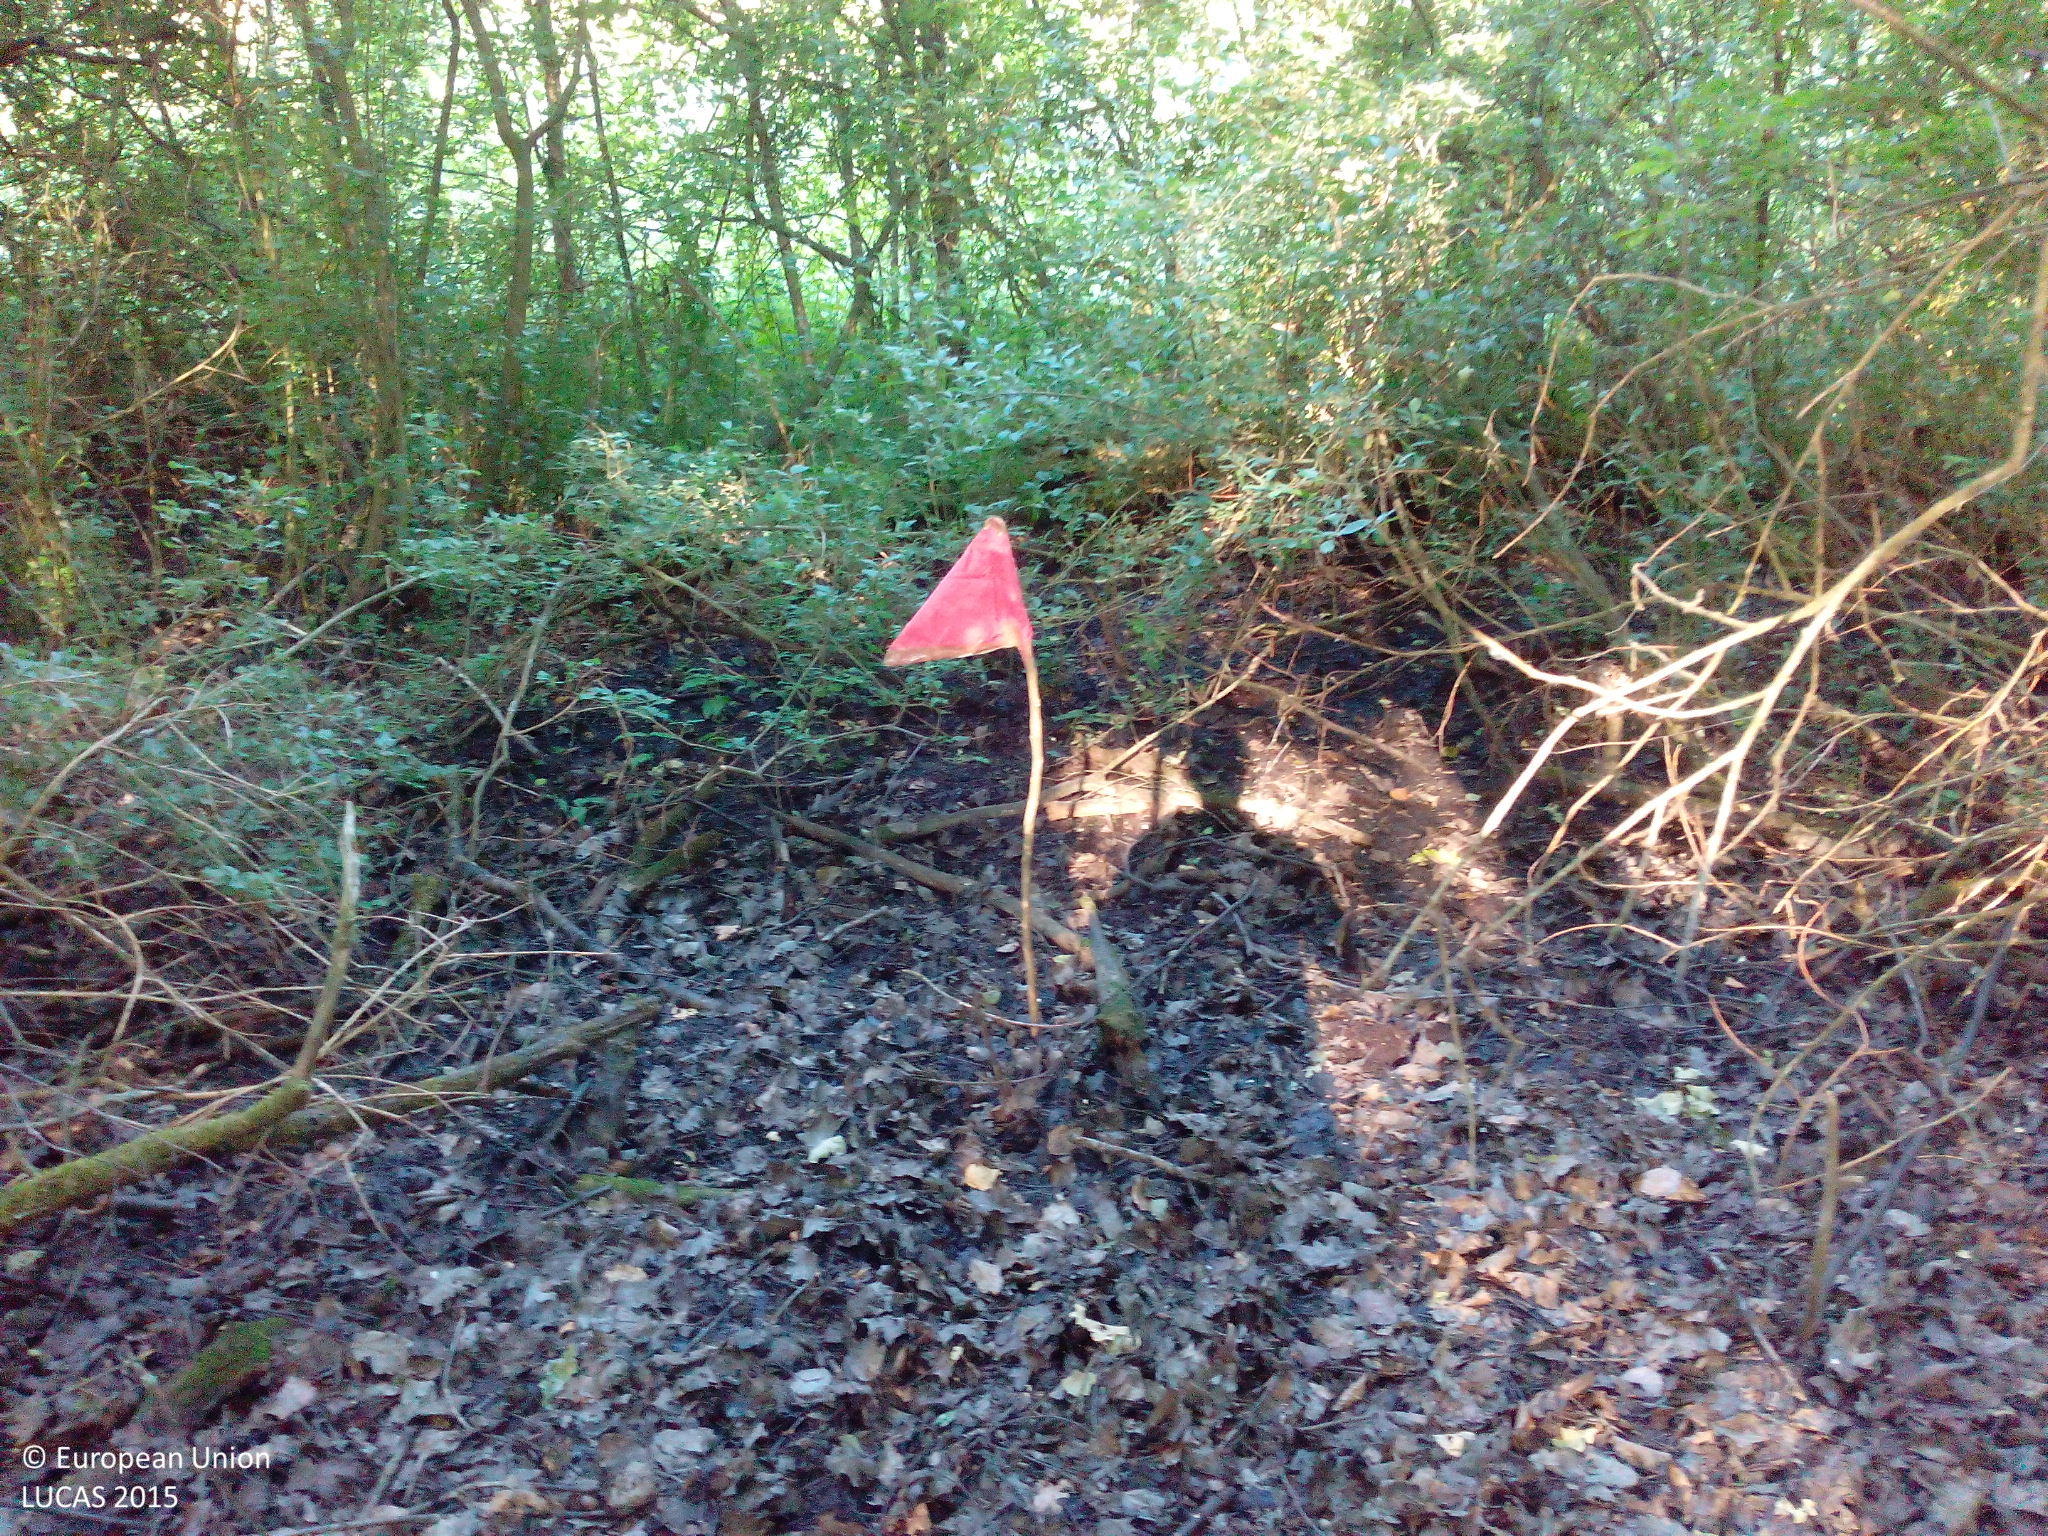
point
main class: Woodland
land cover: Broadleaved woodland
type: mire and swamp forests
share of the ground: > 75 %
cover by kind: broadleaved forest trees 95 %, herbaceous plants 5 %
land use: Semi-natural and natural areas not in use
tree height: > 5 m
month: July
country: DE
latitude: 49.7705
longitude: 9.8473
